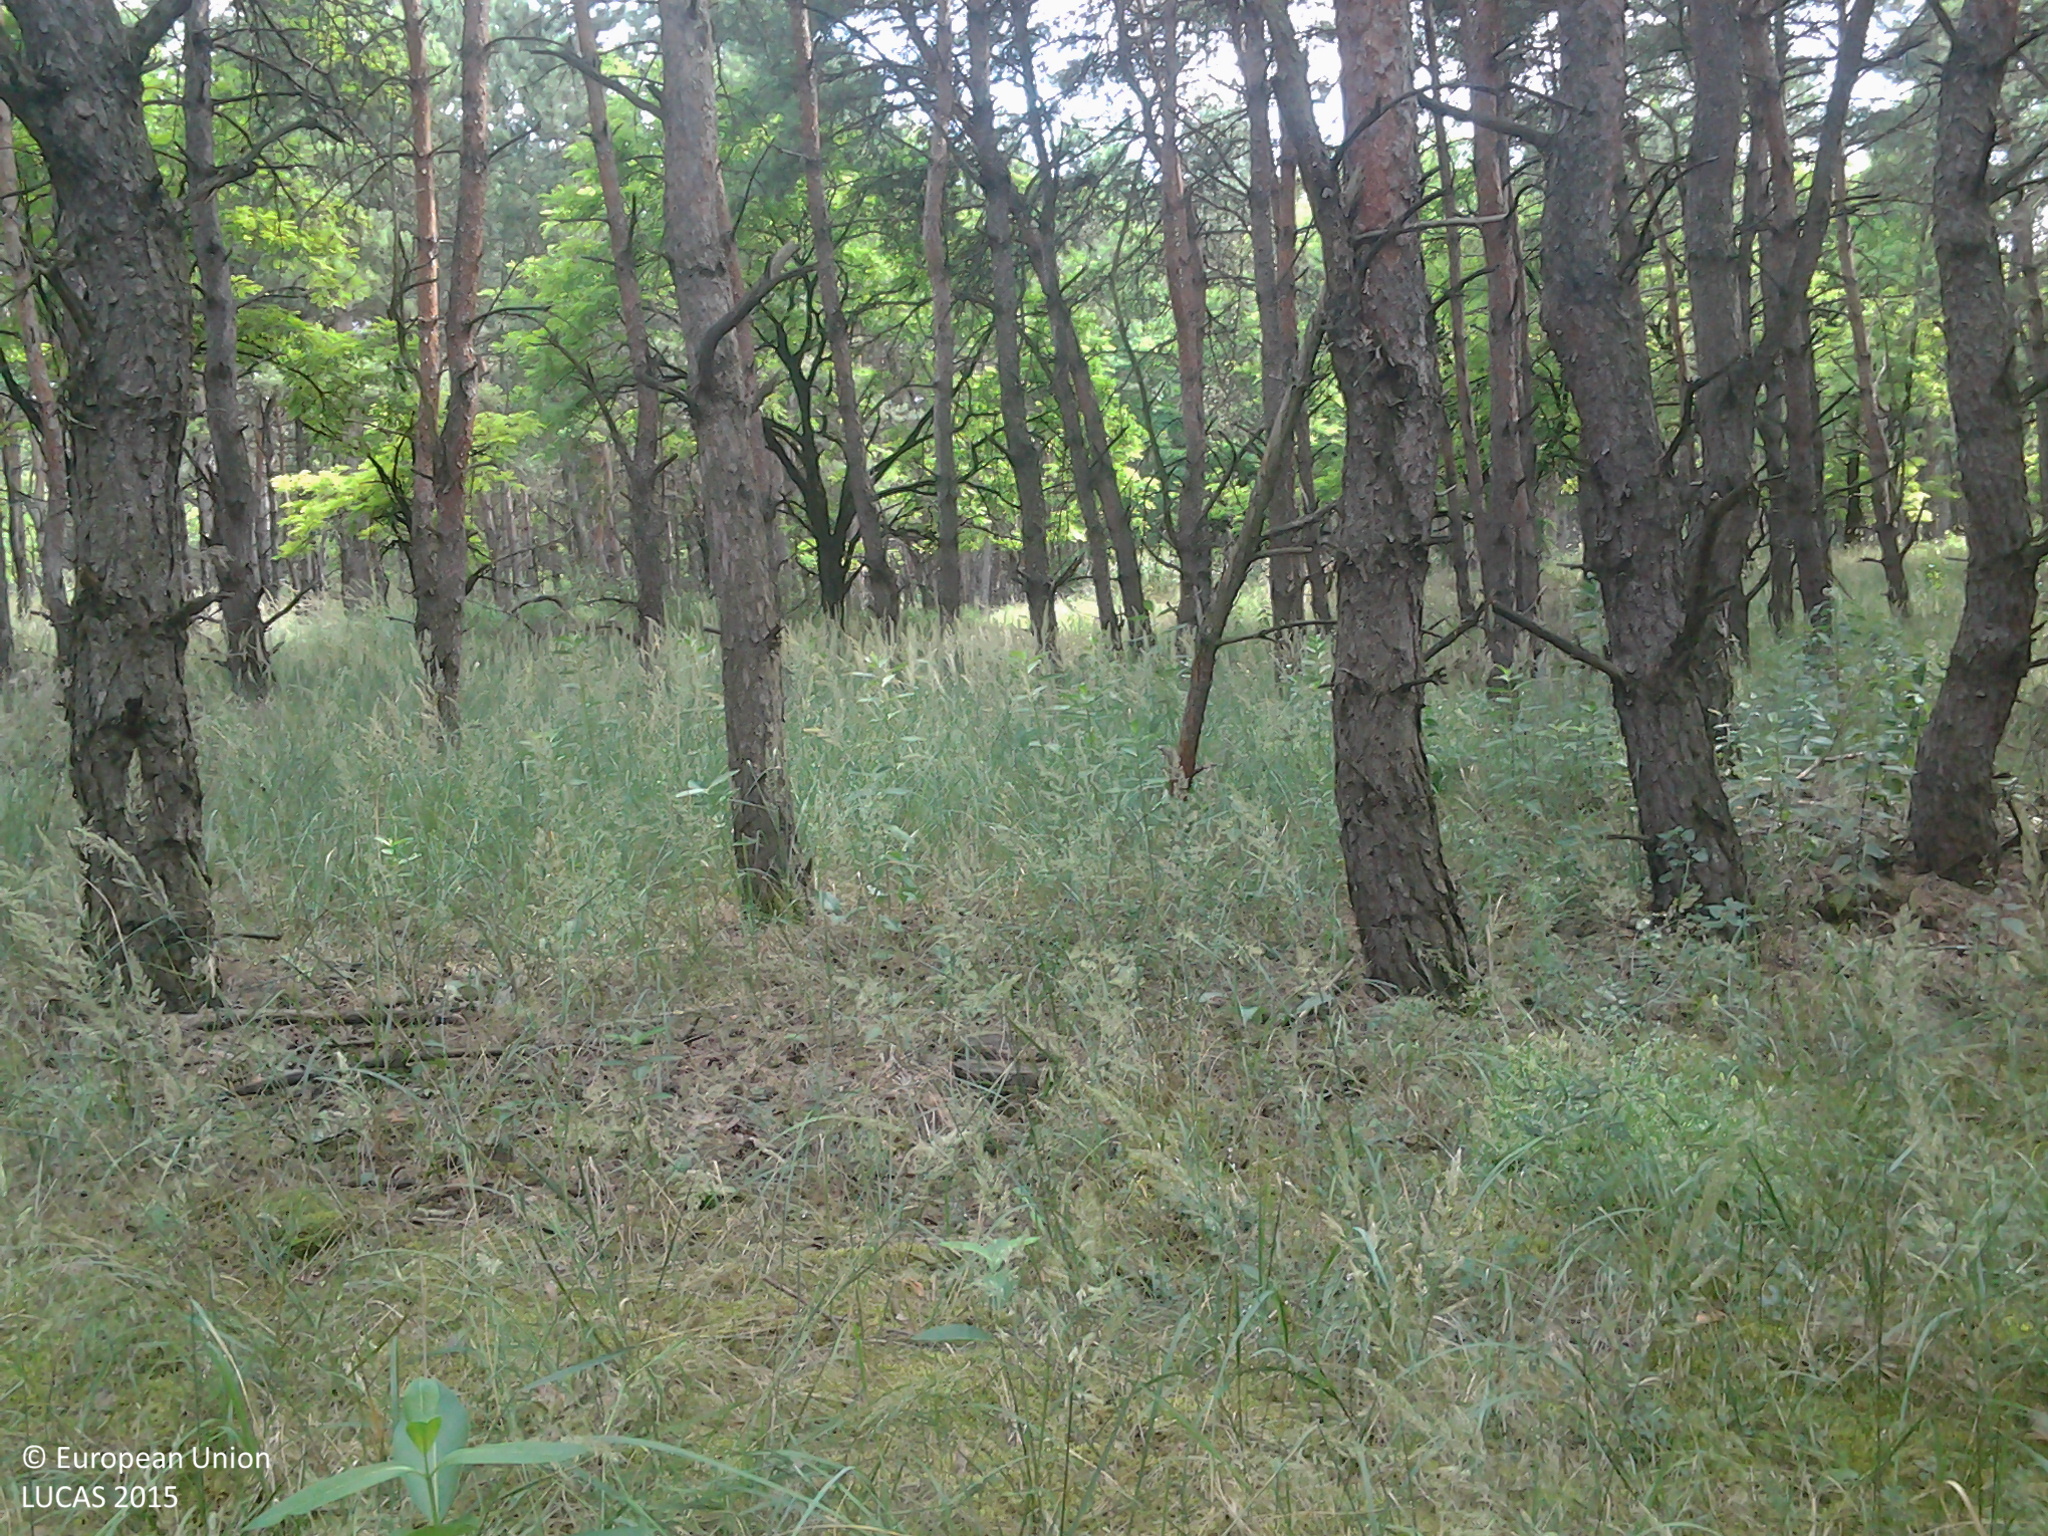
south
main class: Woodland
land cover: Pine dominated coniferous woodland
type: hemiboreal forest and nemoral coniferous forest and mixed broadleaved-coniferous forest
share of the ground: 50 - 75 %
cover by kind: coniferous forest trees 75 %, herbaceous plants 25 %
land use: Forestry
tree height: > 5 m
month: June
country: HU
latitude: 46.6325
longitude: 19.7249
